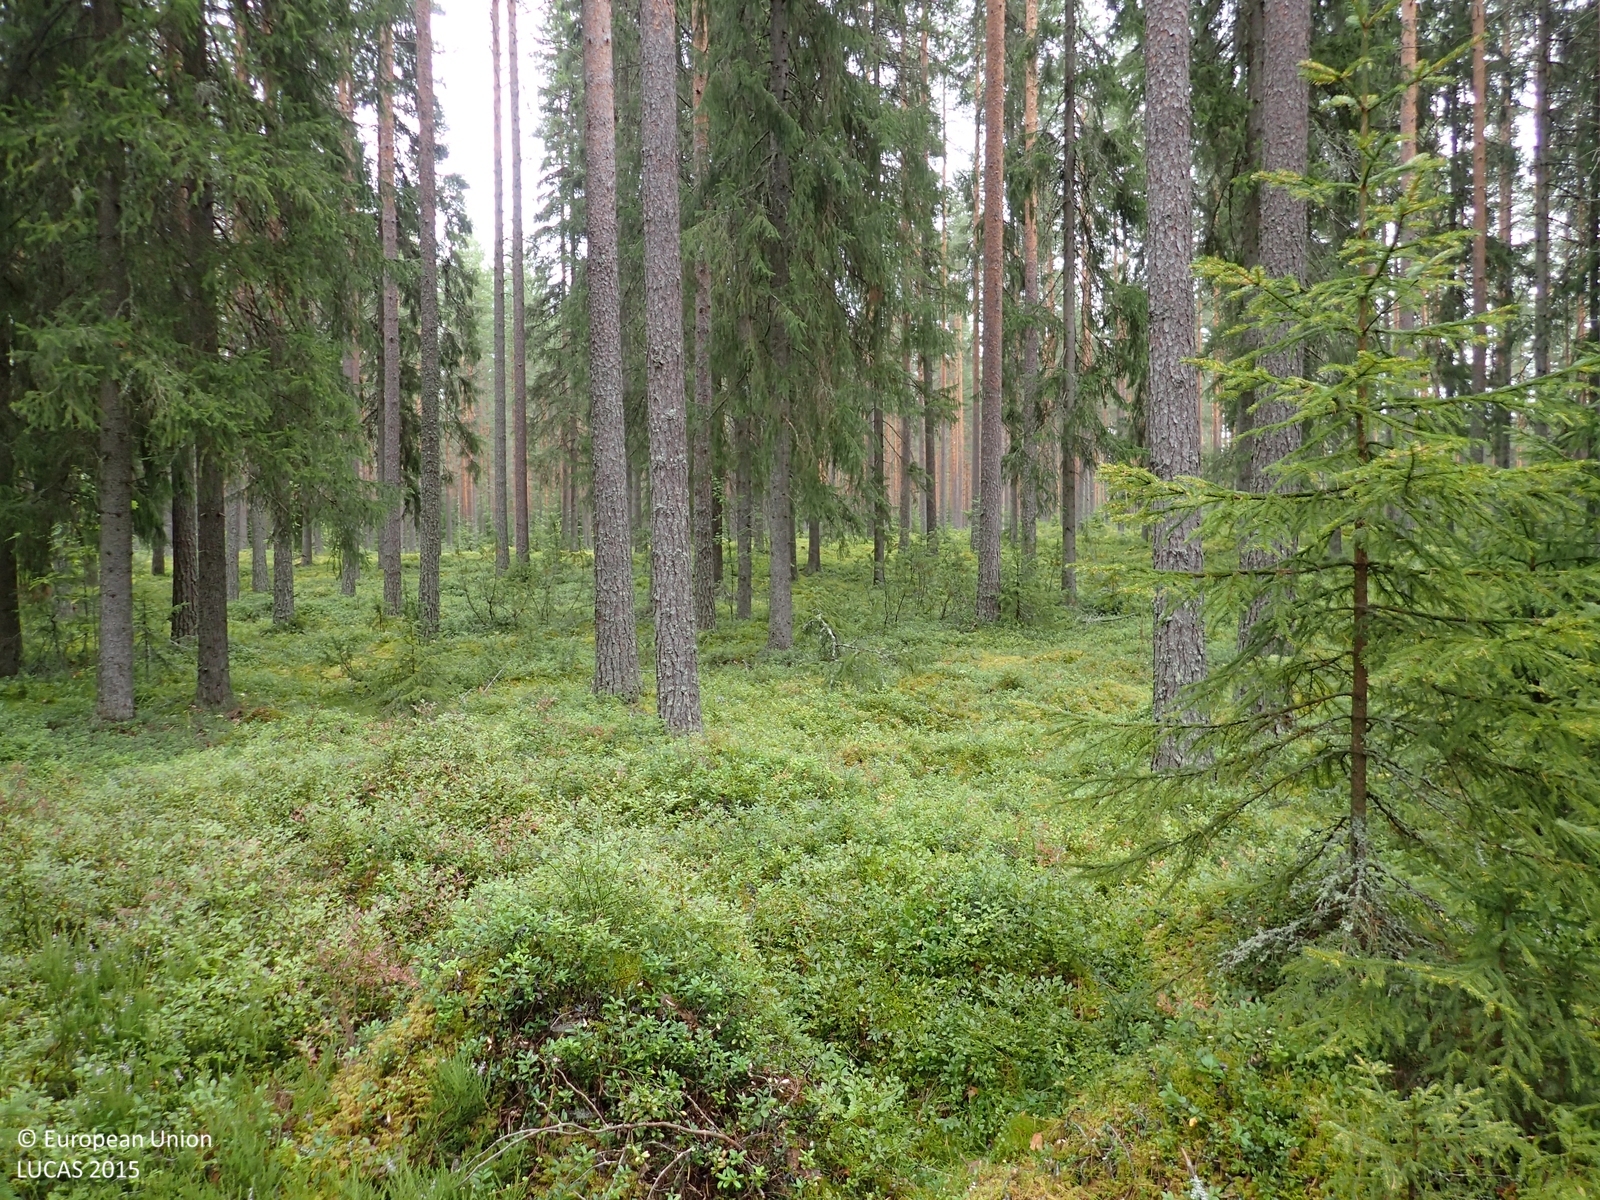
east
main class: Woodland
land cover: Other coniferous woodland
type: boreal forest
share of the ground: 50 - 75 %
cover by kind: coniferous forest trees 70 %, shrubs 20 %, lichens and mosses 10 %
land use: Forestry
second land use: Amenities, museums, leisure
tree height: > 5 m
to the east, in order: Other coniferous woodland; Pine dominated coniferous woodland
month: August
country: FI
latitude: 62.7476
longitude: 22.7218
